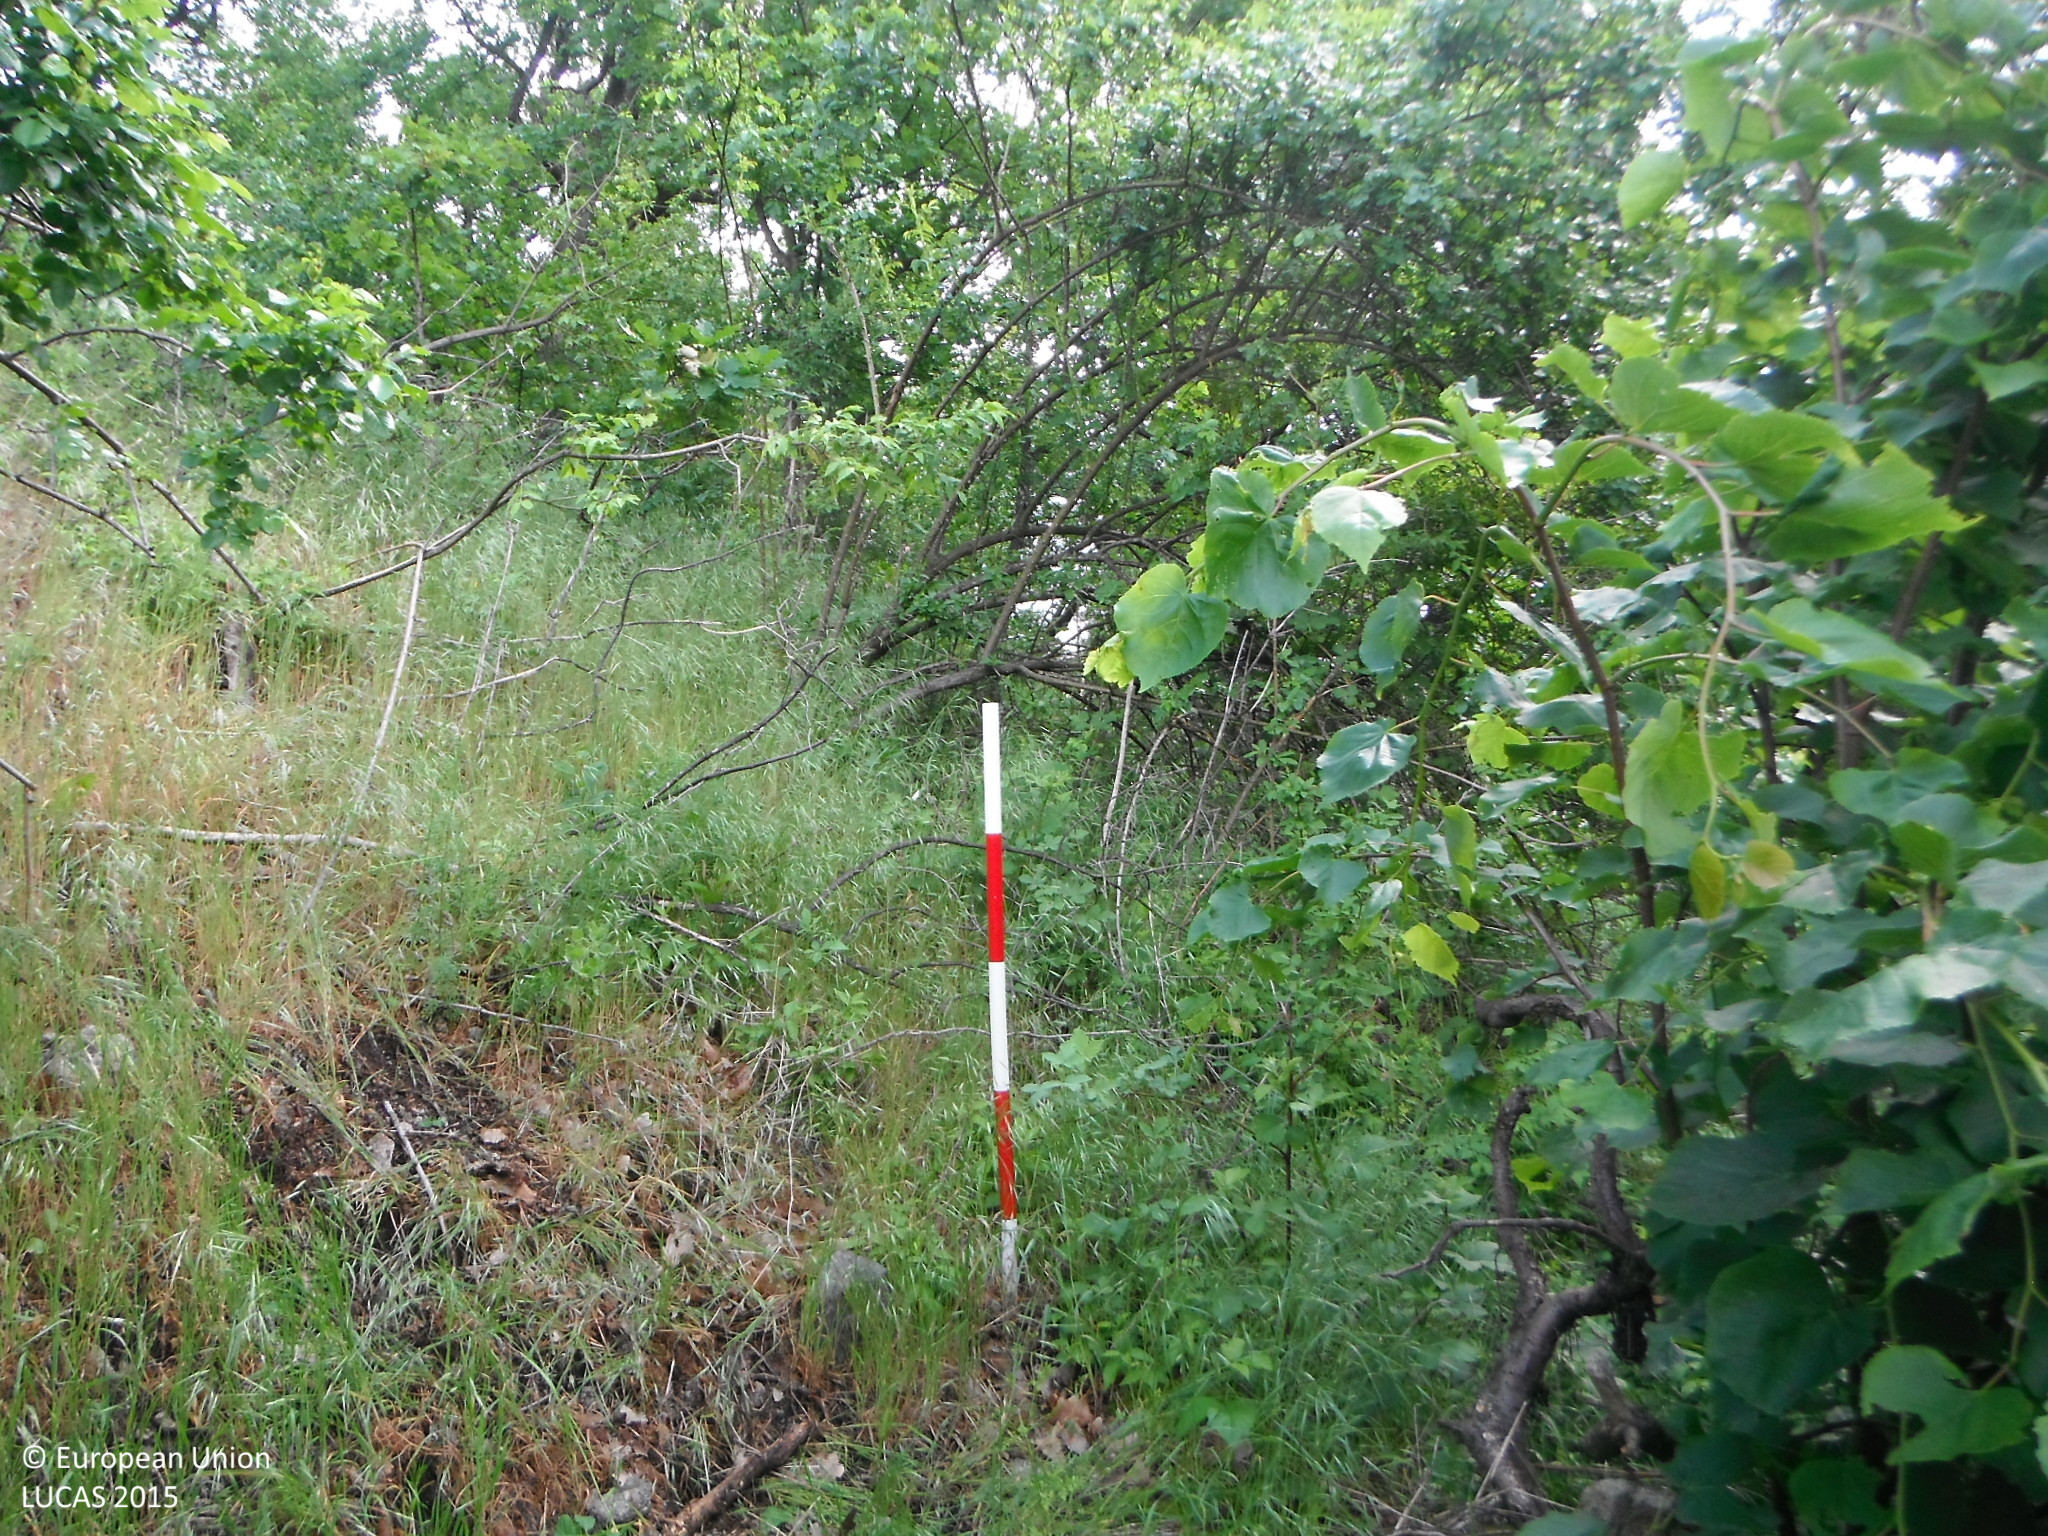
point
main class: Woodland
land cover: Broadleaved woodland
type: acidophilous oak and oak-birch forest
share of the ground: > 75 %
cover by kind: broadleaved forest trees 80 %, shrubs 10 %, herbaceous plants 10 %
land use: Forestry
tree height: > 5 m
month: May
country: SK
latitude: 48.2418
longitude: 17.1856
